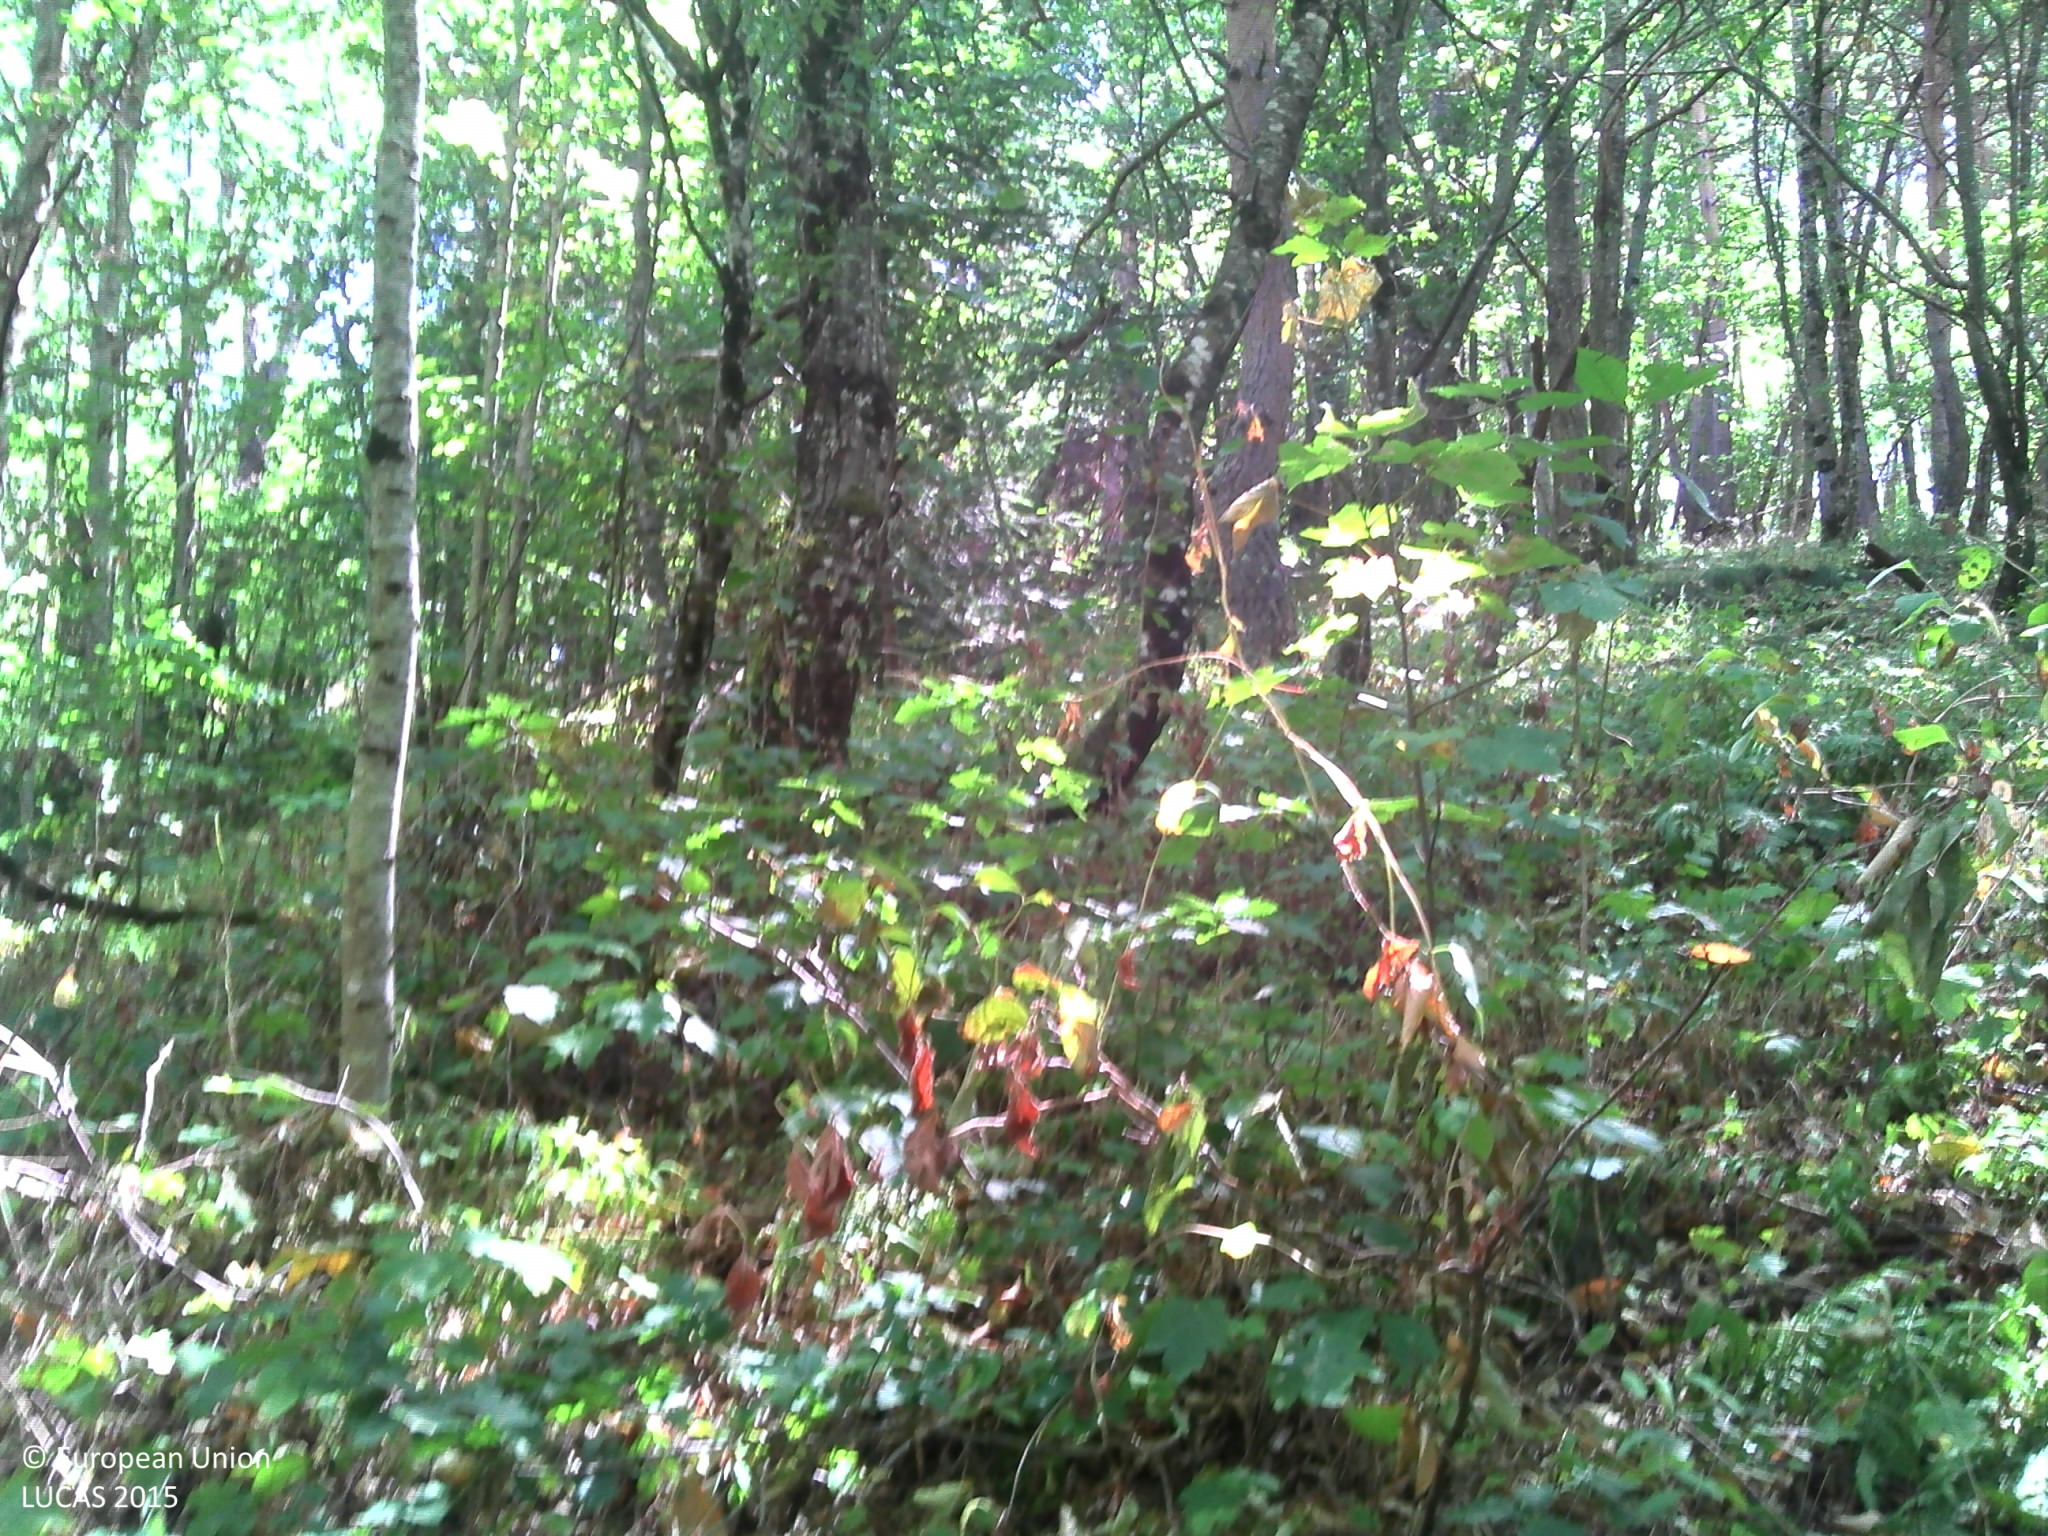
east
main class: Woodland
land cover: Broadleaved woodland
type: broadleaved evergreen forest
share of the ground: > 75 %
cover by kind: broadleaved forest trees 100 %
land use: Forestry
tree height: > 5 m
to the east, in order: Broadleaved woodland; Tracks; Fences; Grassland with sparse tree/shrub cover; Fences; Abandoned hedges; Paved roads, cycling and walking lanes; Broadleaved woodland; Electric lines; Pine dominated mixed woodland; Grassland without tree/shrub cover
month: July
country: FR
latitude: 44.9710
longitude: 4.6420
